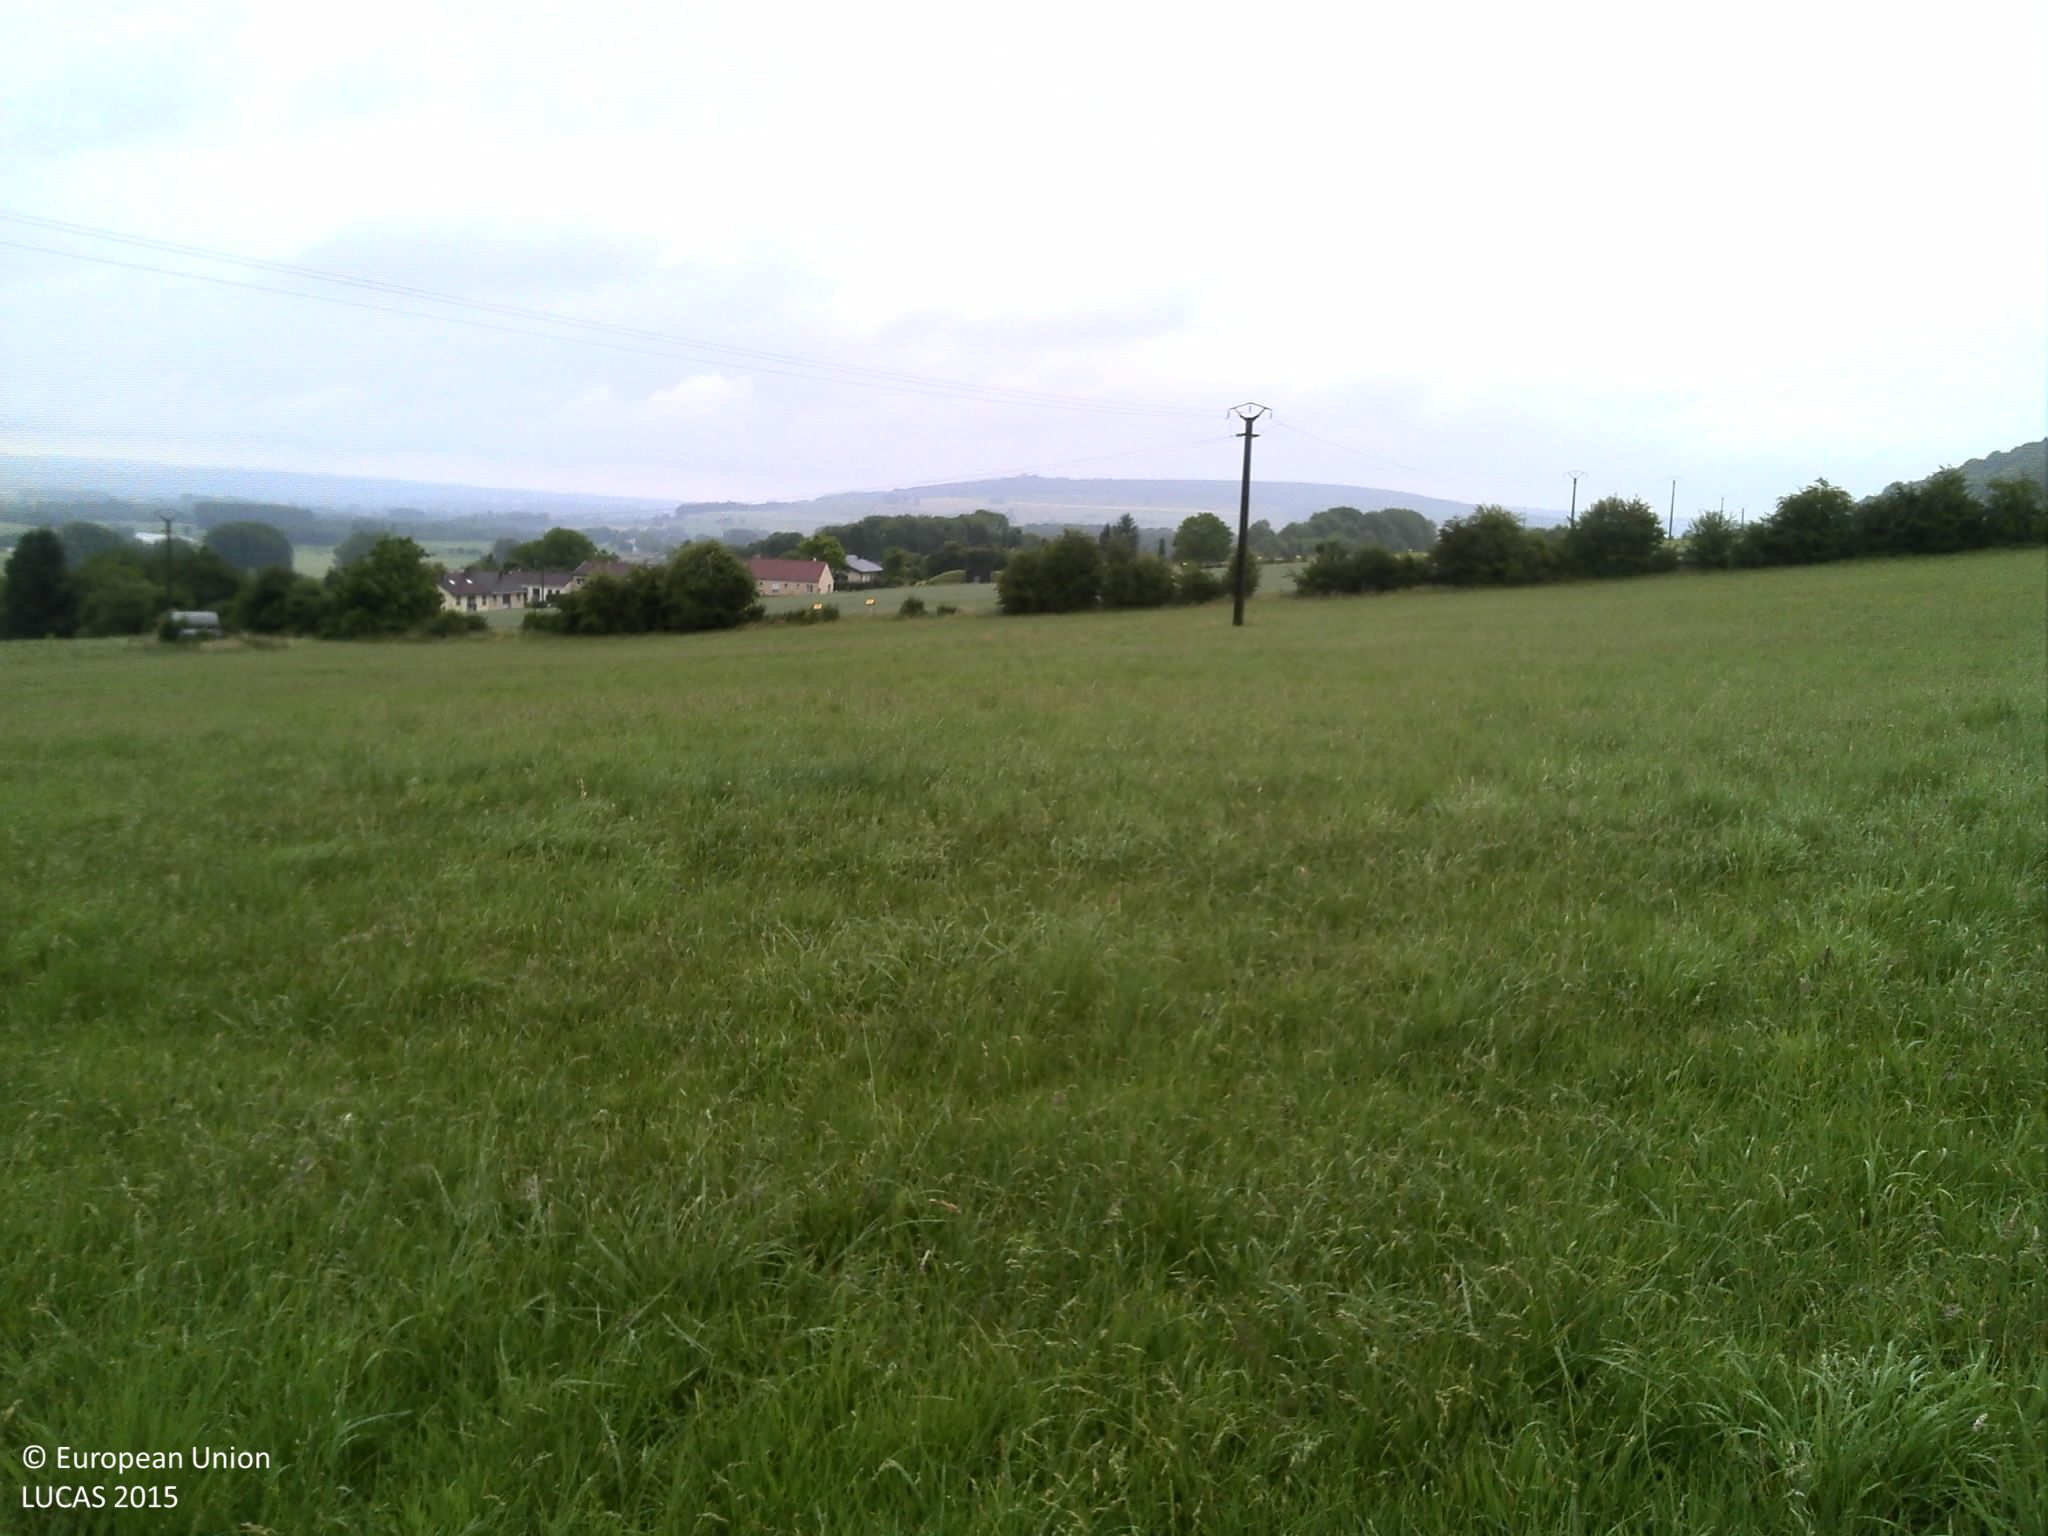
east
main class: Grassland
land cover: Grassland without tree/shrub cover
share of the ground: > 75 %
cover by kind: herbaceous plants 100 %
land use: Agriculture (excluding fallow land and kitchen gardens)
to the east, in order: Grassland without tree/shrub cover; Electric lines; Grassland without tree/shrub cover; Electric lines; Grassland without tree/shrub cover; Fences; Abandoned hedges; Common wheat
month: June
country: FR
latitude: 49.6872
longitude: 4.7990
